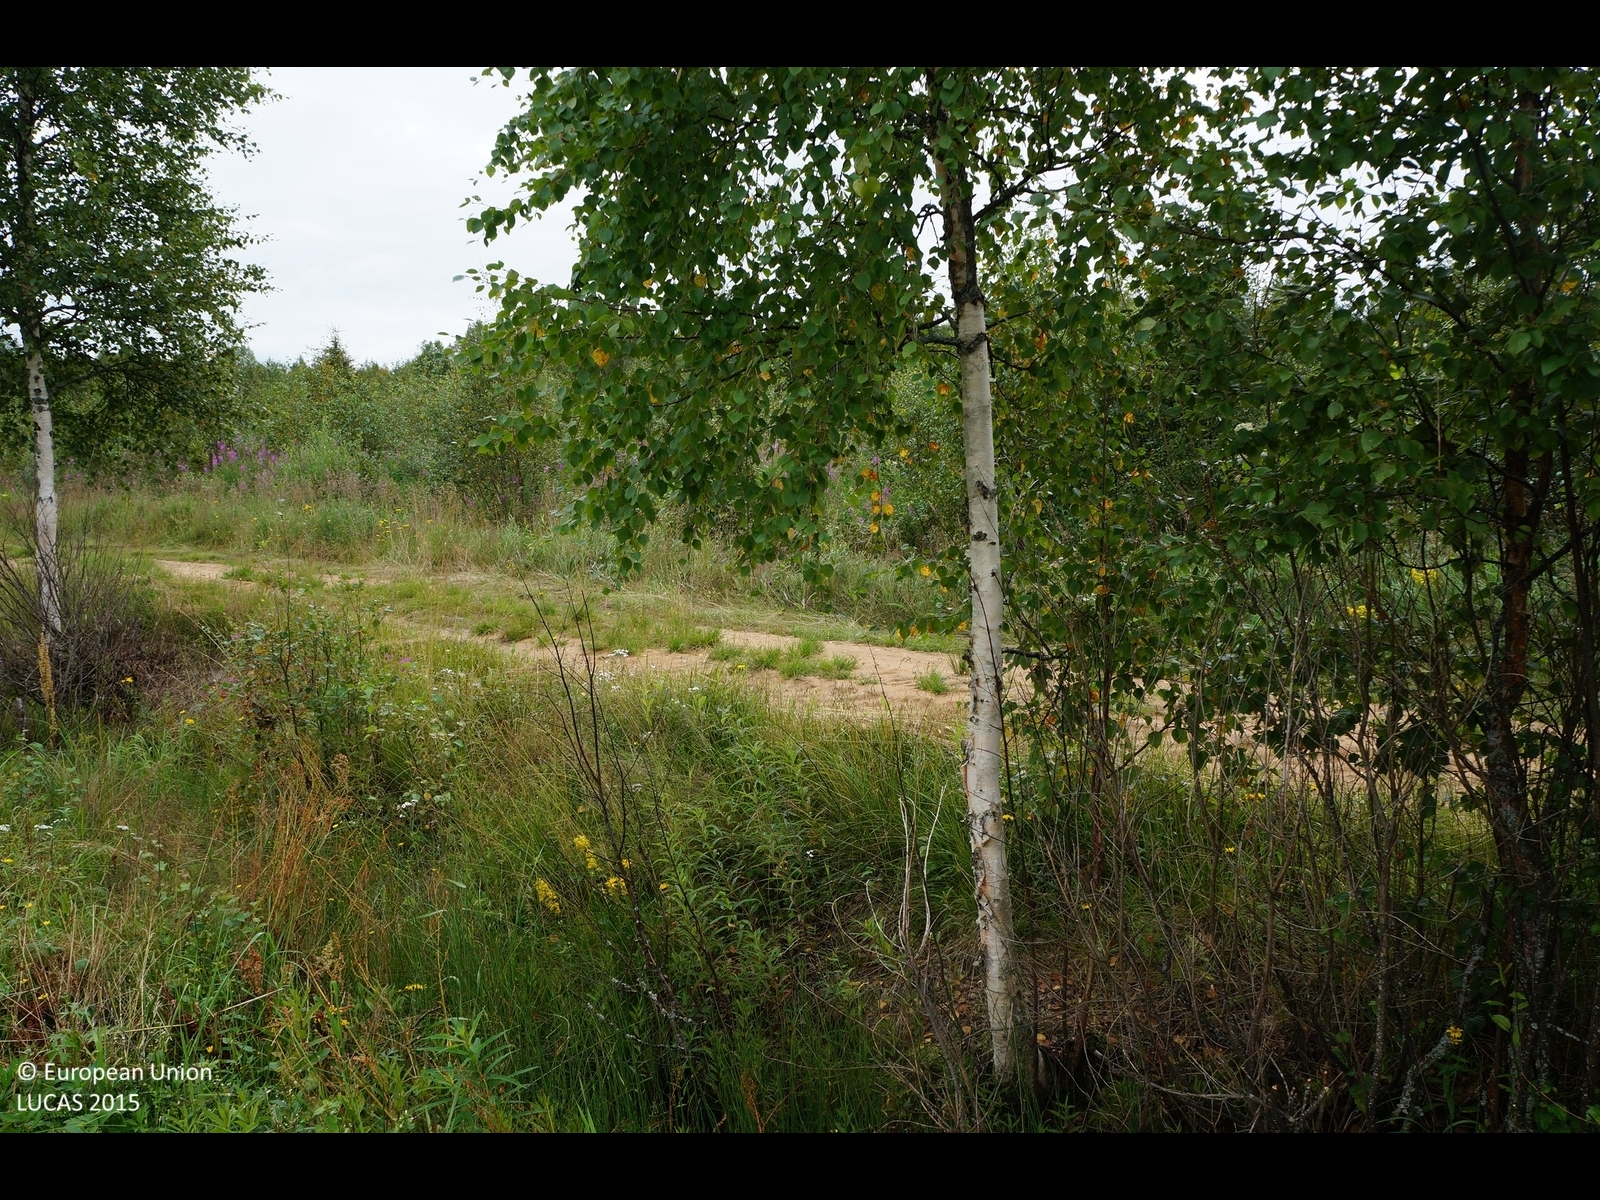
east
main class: Cropland
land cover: Barley
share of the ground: > 75 %
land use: Agriculture (excluding fallow land and kitchen gardens)
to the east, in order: Barley; Ditches and canals; Barley; Ditches and canals; Barley; Grass margins; Ditches and canals; Tracks; Grass margins; Ditches and canals; Broadleaved woodland; Ditches and canals; Broadleaved woodland; Ditches and canals; Broadleaved woodland; Ditches and canals; Broadleaved woodland; Ditches and canals; Broadleaved woodland; Ditches and canals; Broadleaved woodland; Ditches and canals; Broadleaved woodland; Ditches and canals; Broadleaved woodland; Ditches and canals; Broadleaved woodland; Ditches and canals; Broadleaved woodland
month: August
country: FI
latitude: 64.3356
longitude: 26.0181
